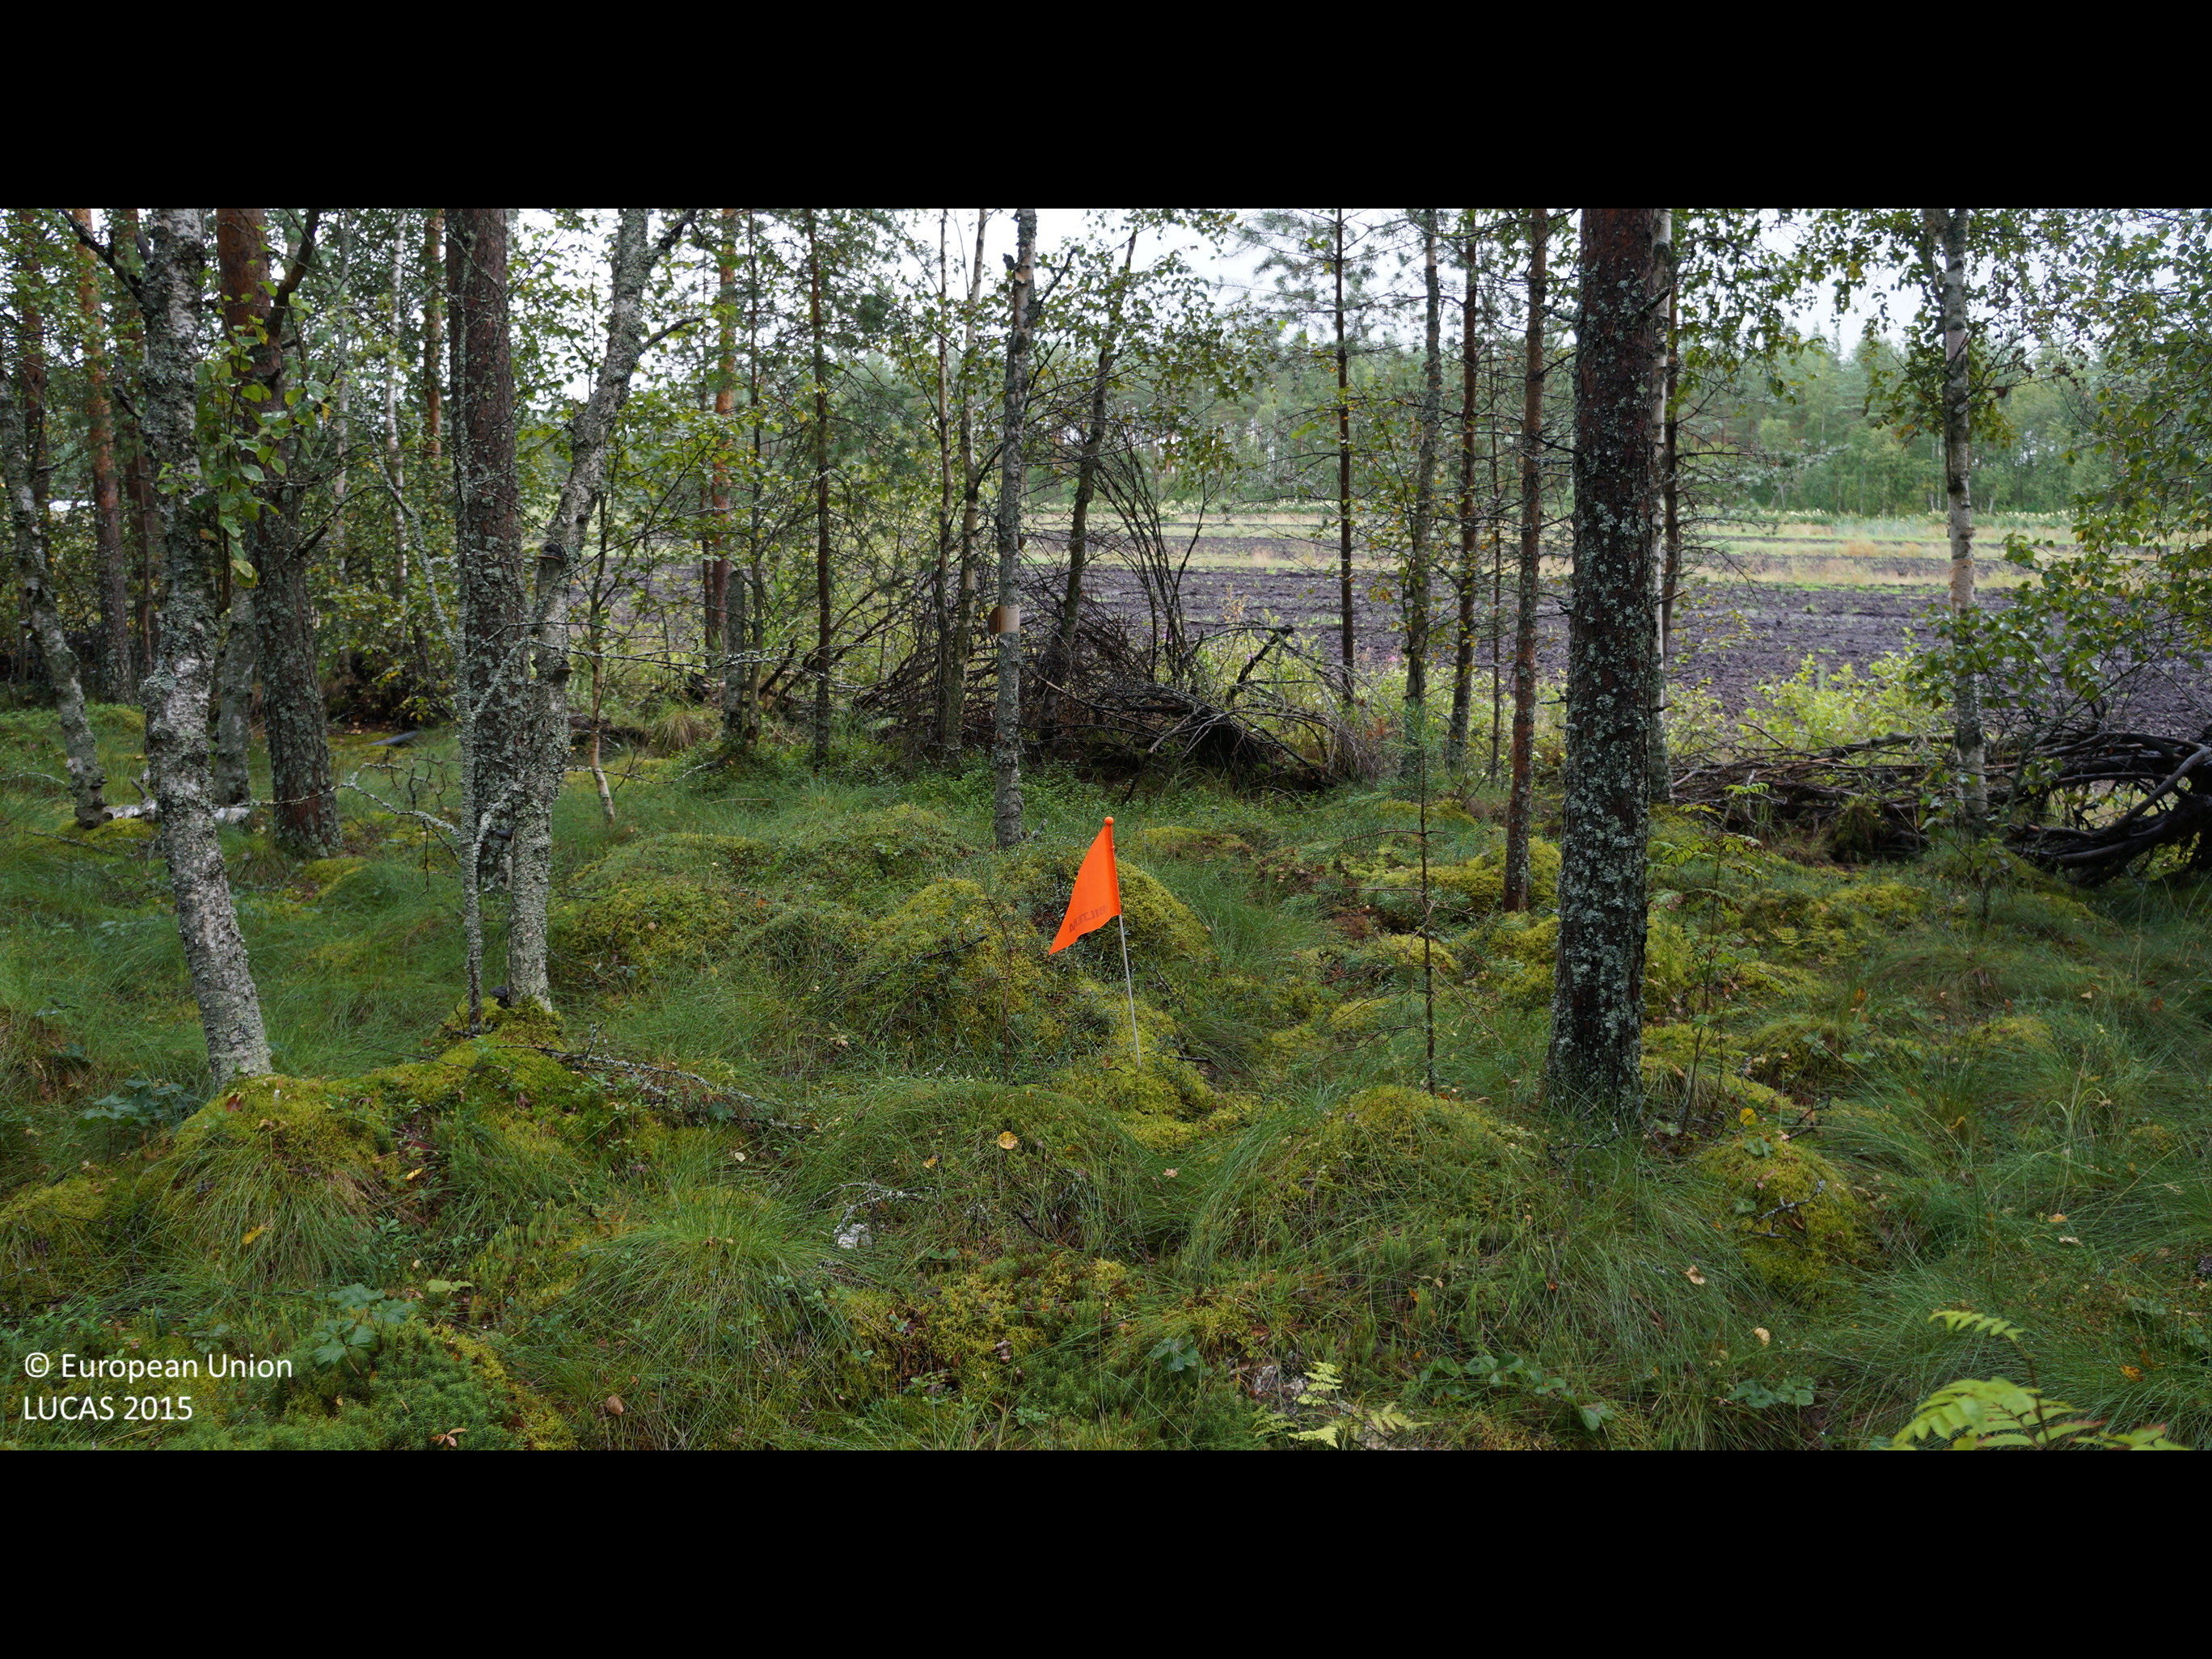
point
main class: Woodland
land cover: Pine dominated mixed woodland
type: boreal forest
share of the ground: 50 - 75 %
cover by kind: broadleaved forest trees 30 %, coniferous forest trees 25 %, herbaceous plants 25 %, lichens and mosses 15 %, shrubs 5 %
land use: Forestry
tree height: > 5 m
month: August
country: FI
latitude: 64.2334
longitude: 25.7479
